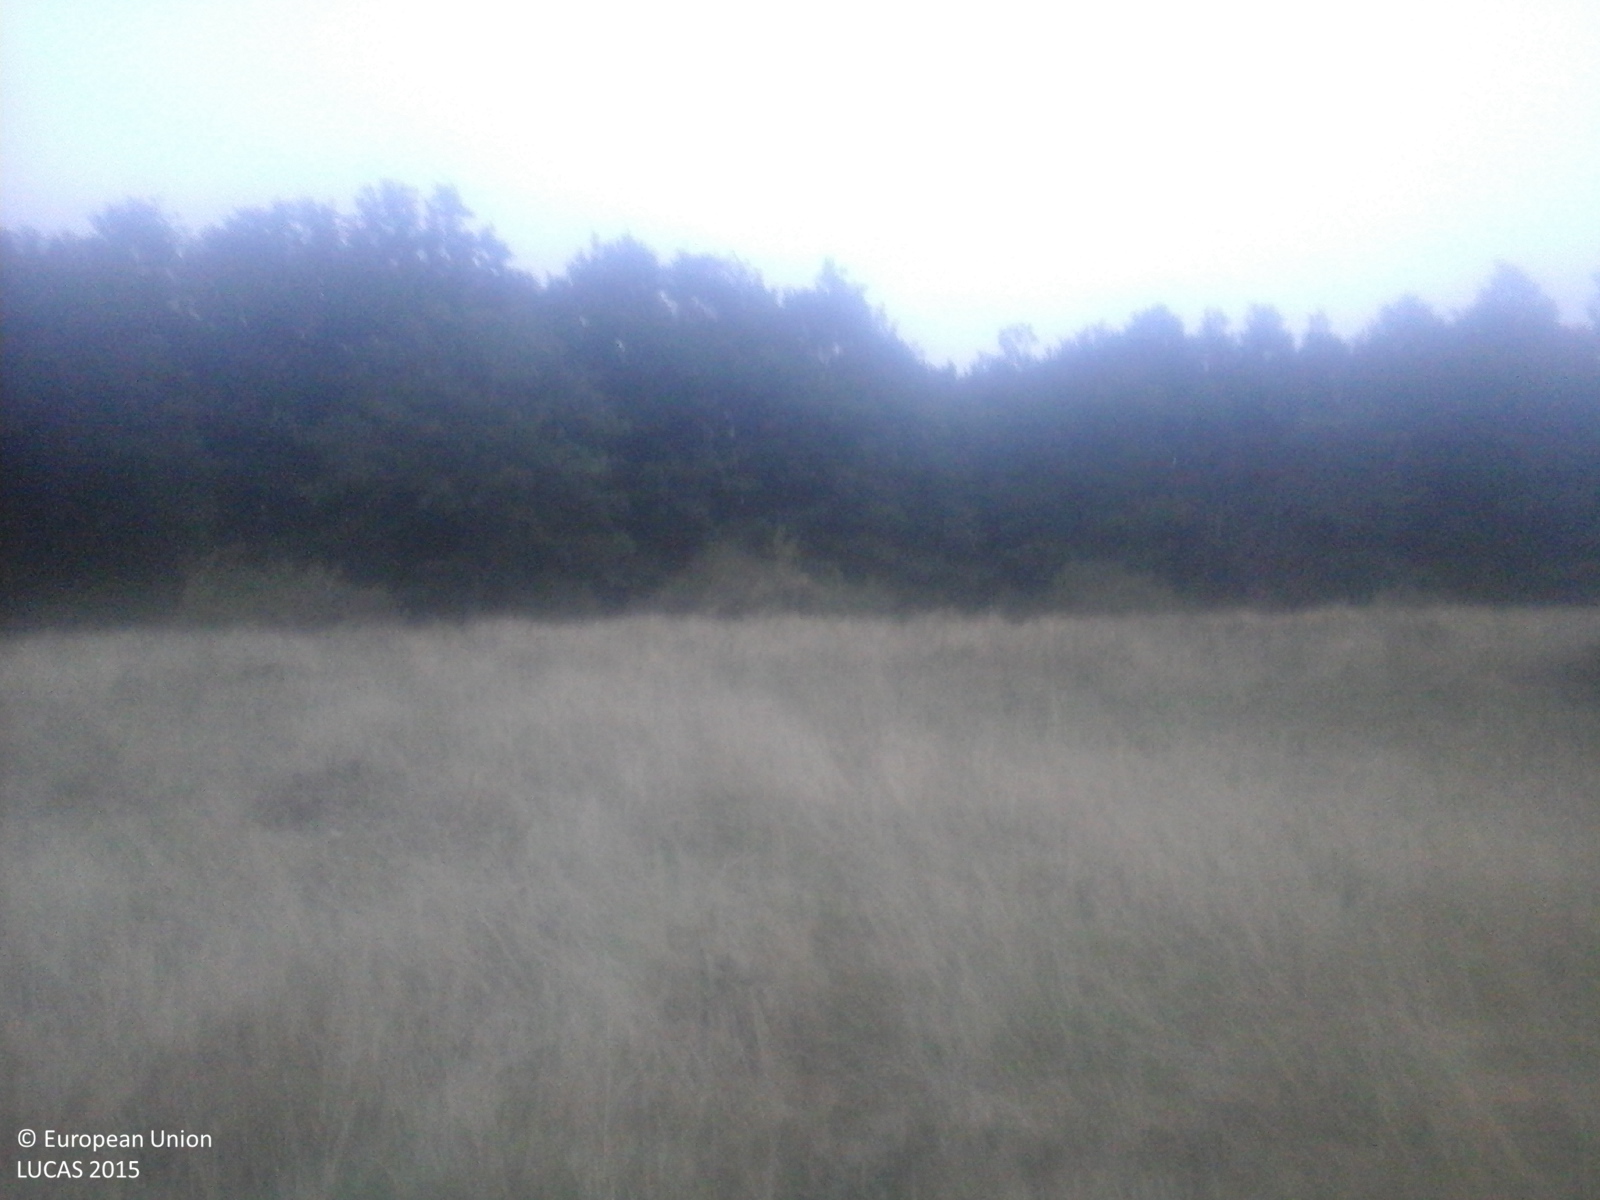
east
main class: Grassland
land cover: Grassland with sparse tree/shrub cover
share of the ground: > 75 %
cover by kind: herbaceous plants 85 %, shrubs 10 %, broadleaved forest trees 5 %
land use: Agriculture (excluding fallow land and kitchen gardens)
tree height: < 5 m
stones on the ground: < 10 %
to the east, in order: Grassland with sparse tree/shrub cover; Tracks; Shrubland without tree cover; Broadleaved woodland
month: September
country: RO
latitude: 45.8611
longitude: 23.3142
